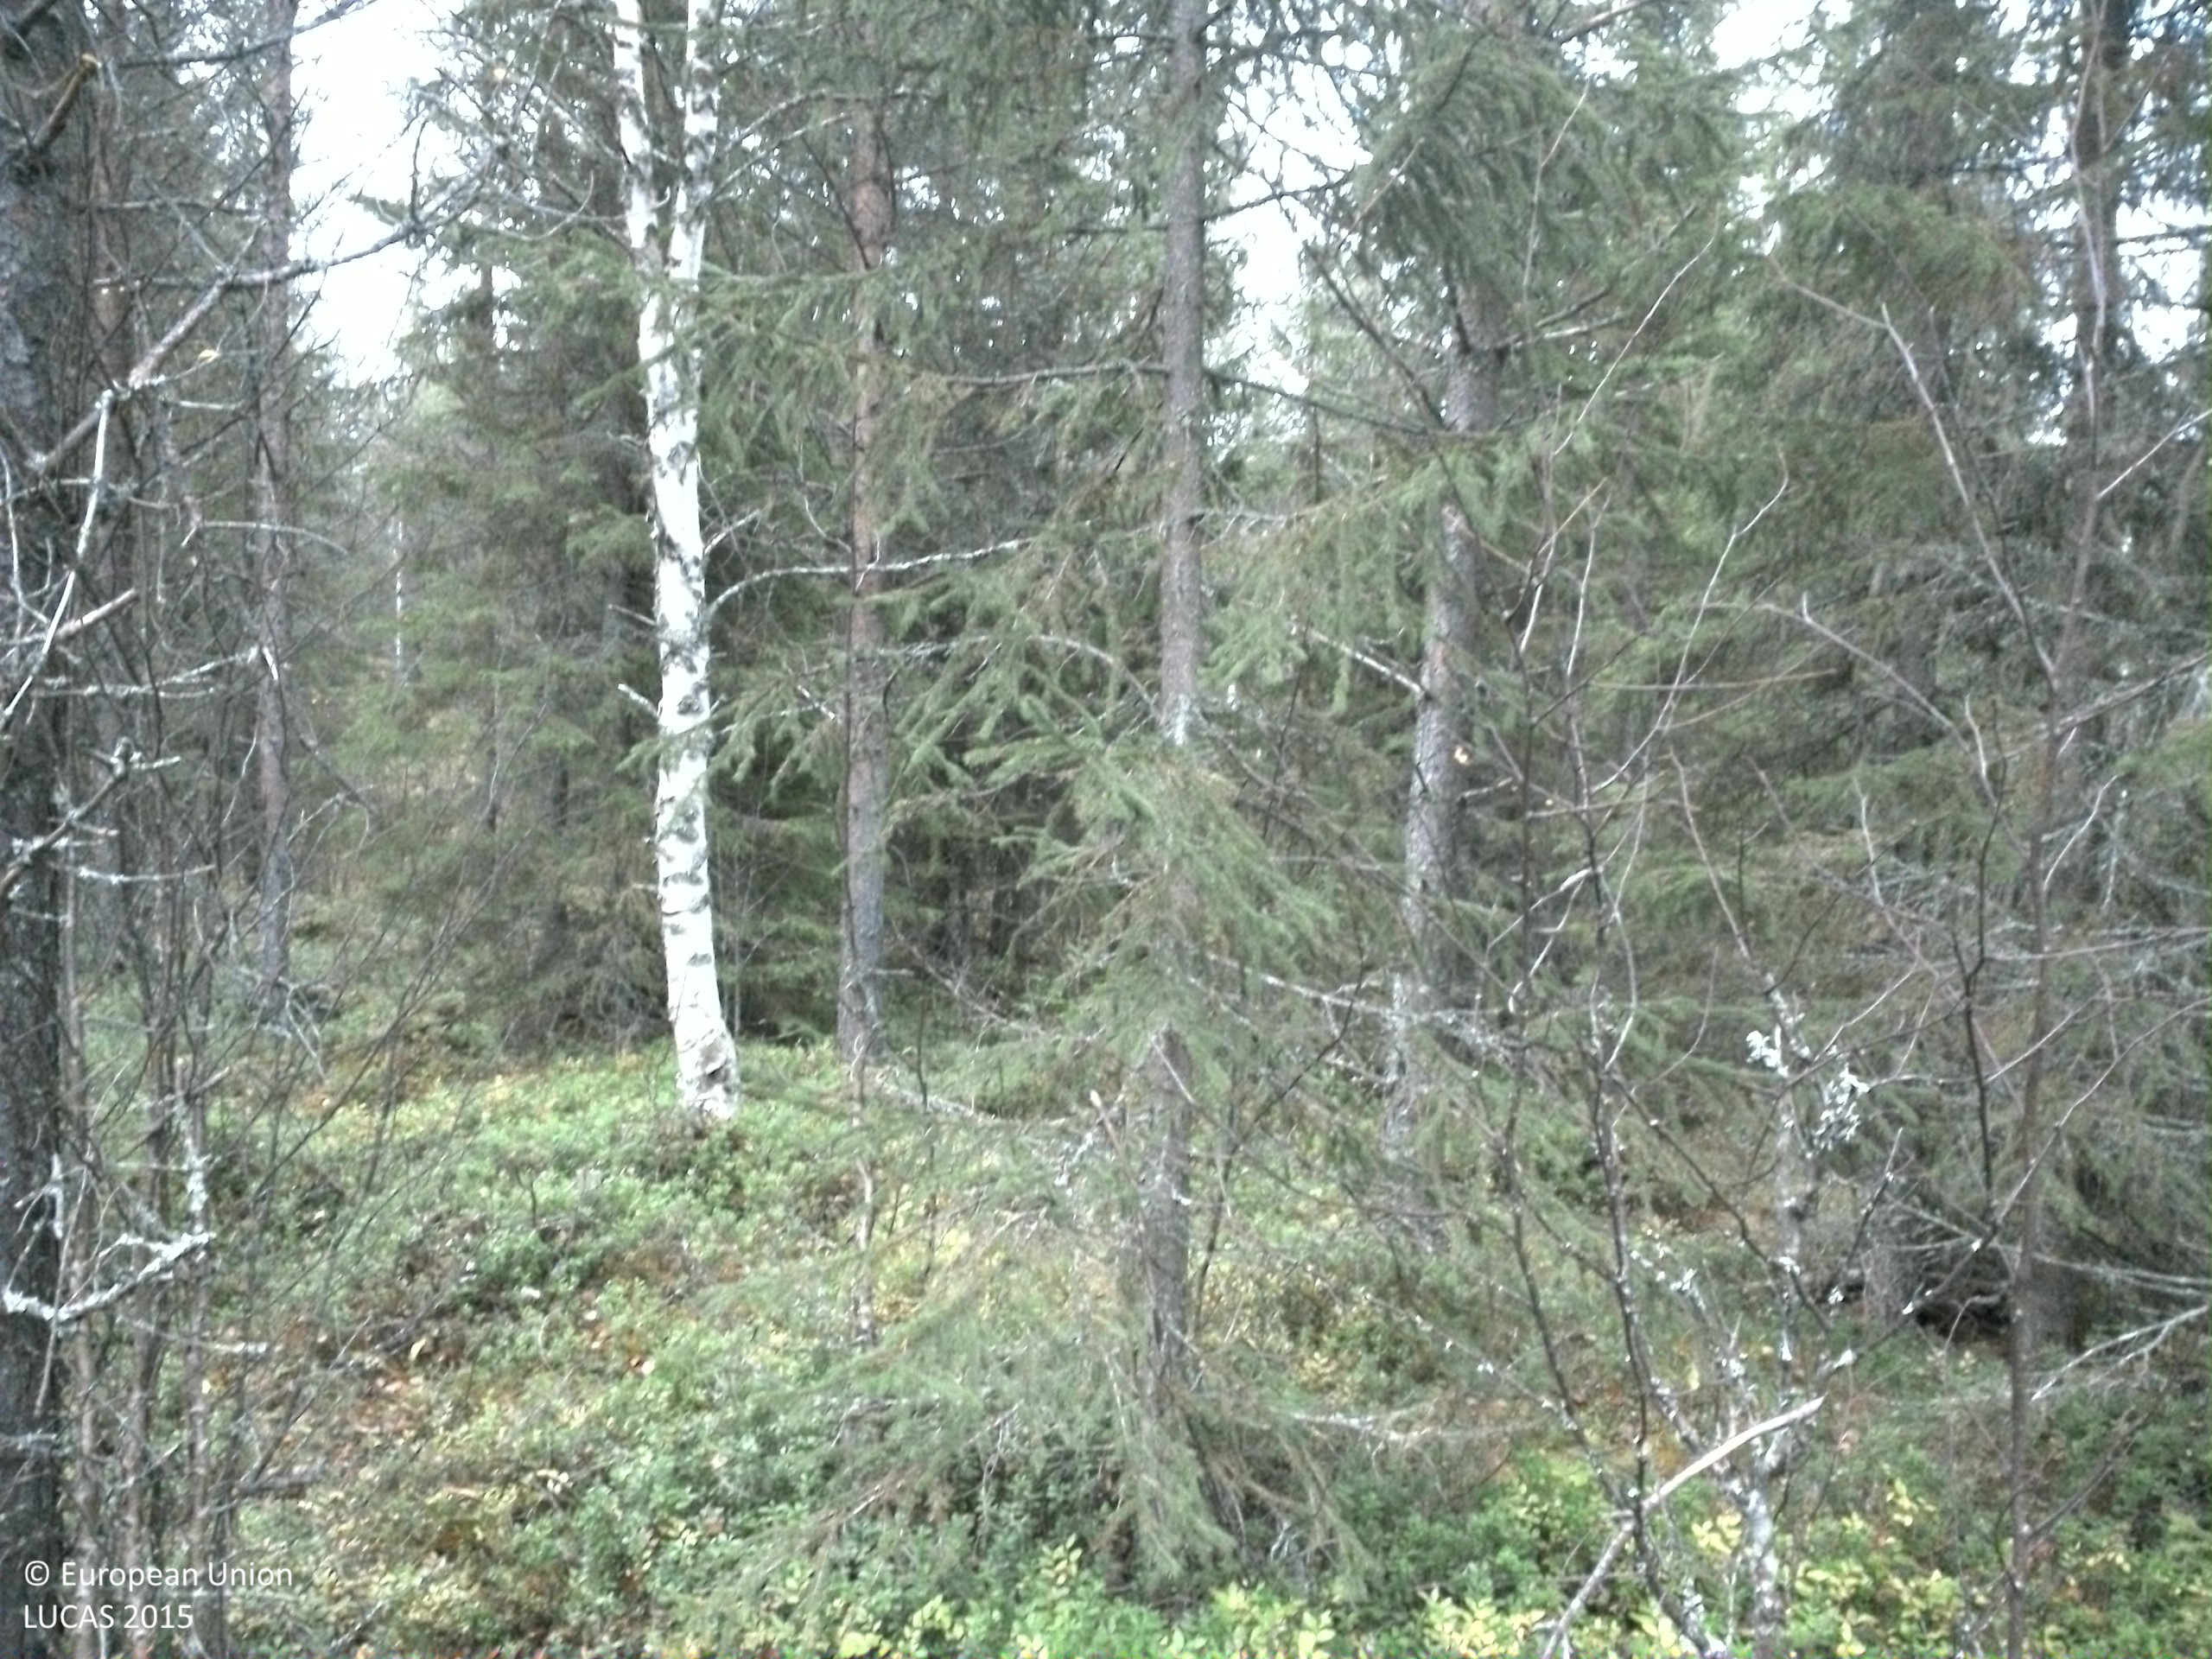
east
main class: Woodland
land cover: Other mixed woodland
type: boreal forest
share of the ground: 50 - 75 %
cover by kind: coniferous forest trees 45 %, shrubs 30 %, broadleaved forest trees 15 %, lichens and mosses 10 %
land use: Forestry
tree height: > 5 m
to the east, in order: Other mixed woodland; Spruce dominated mixed woodland; Spruce dominated coniferous woodland; Spruce dominated mixed woodland
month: October
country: SE
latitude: 64.3101
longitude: 15.2852
